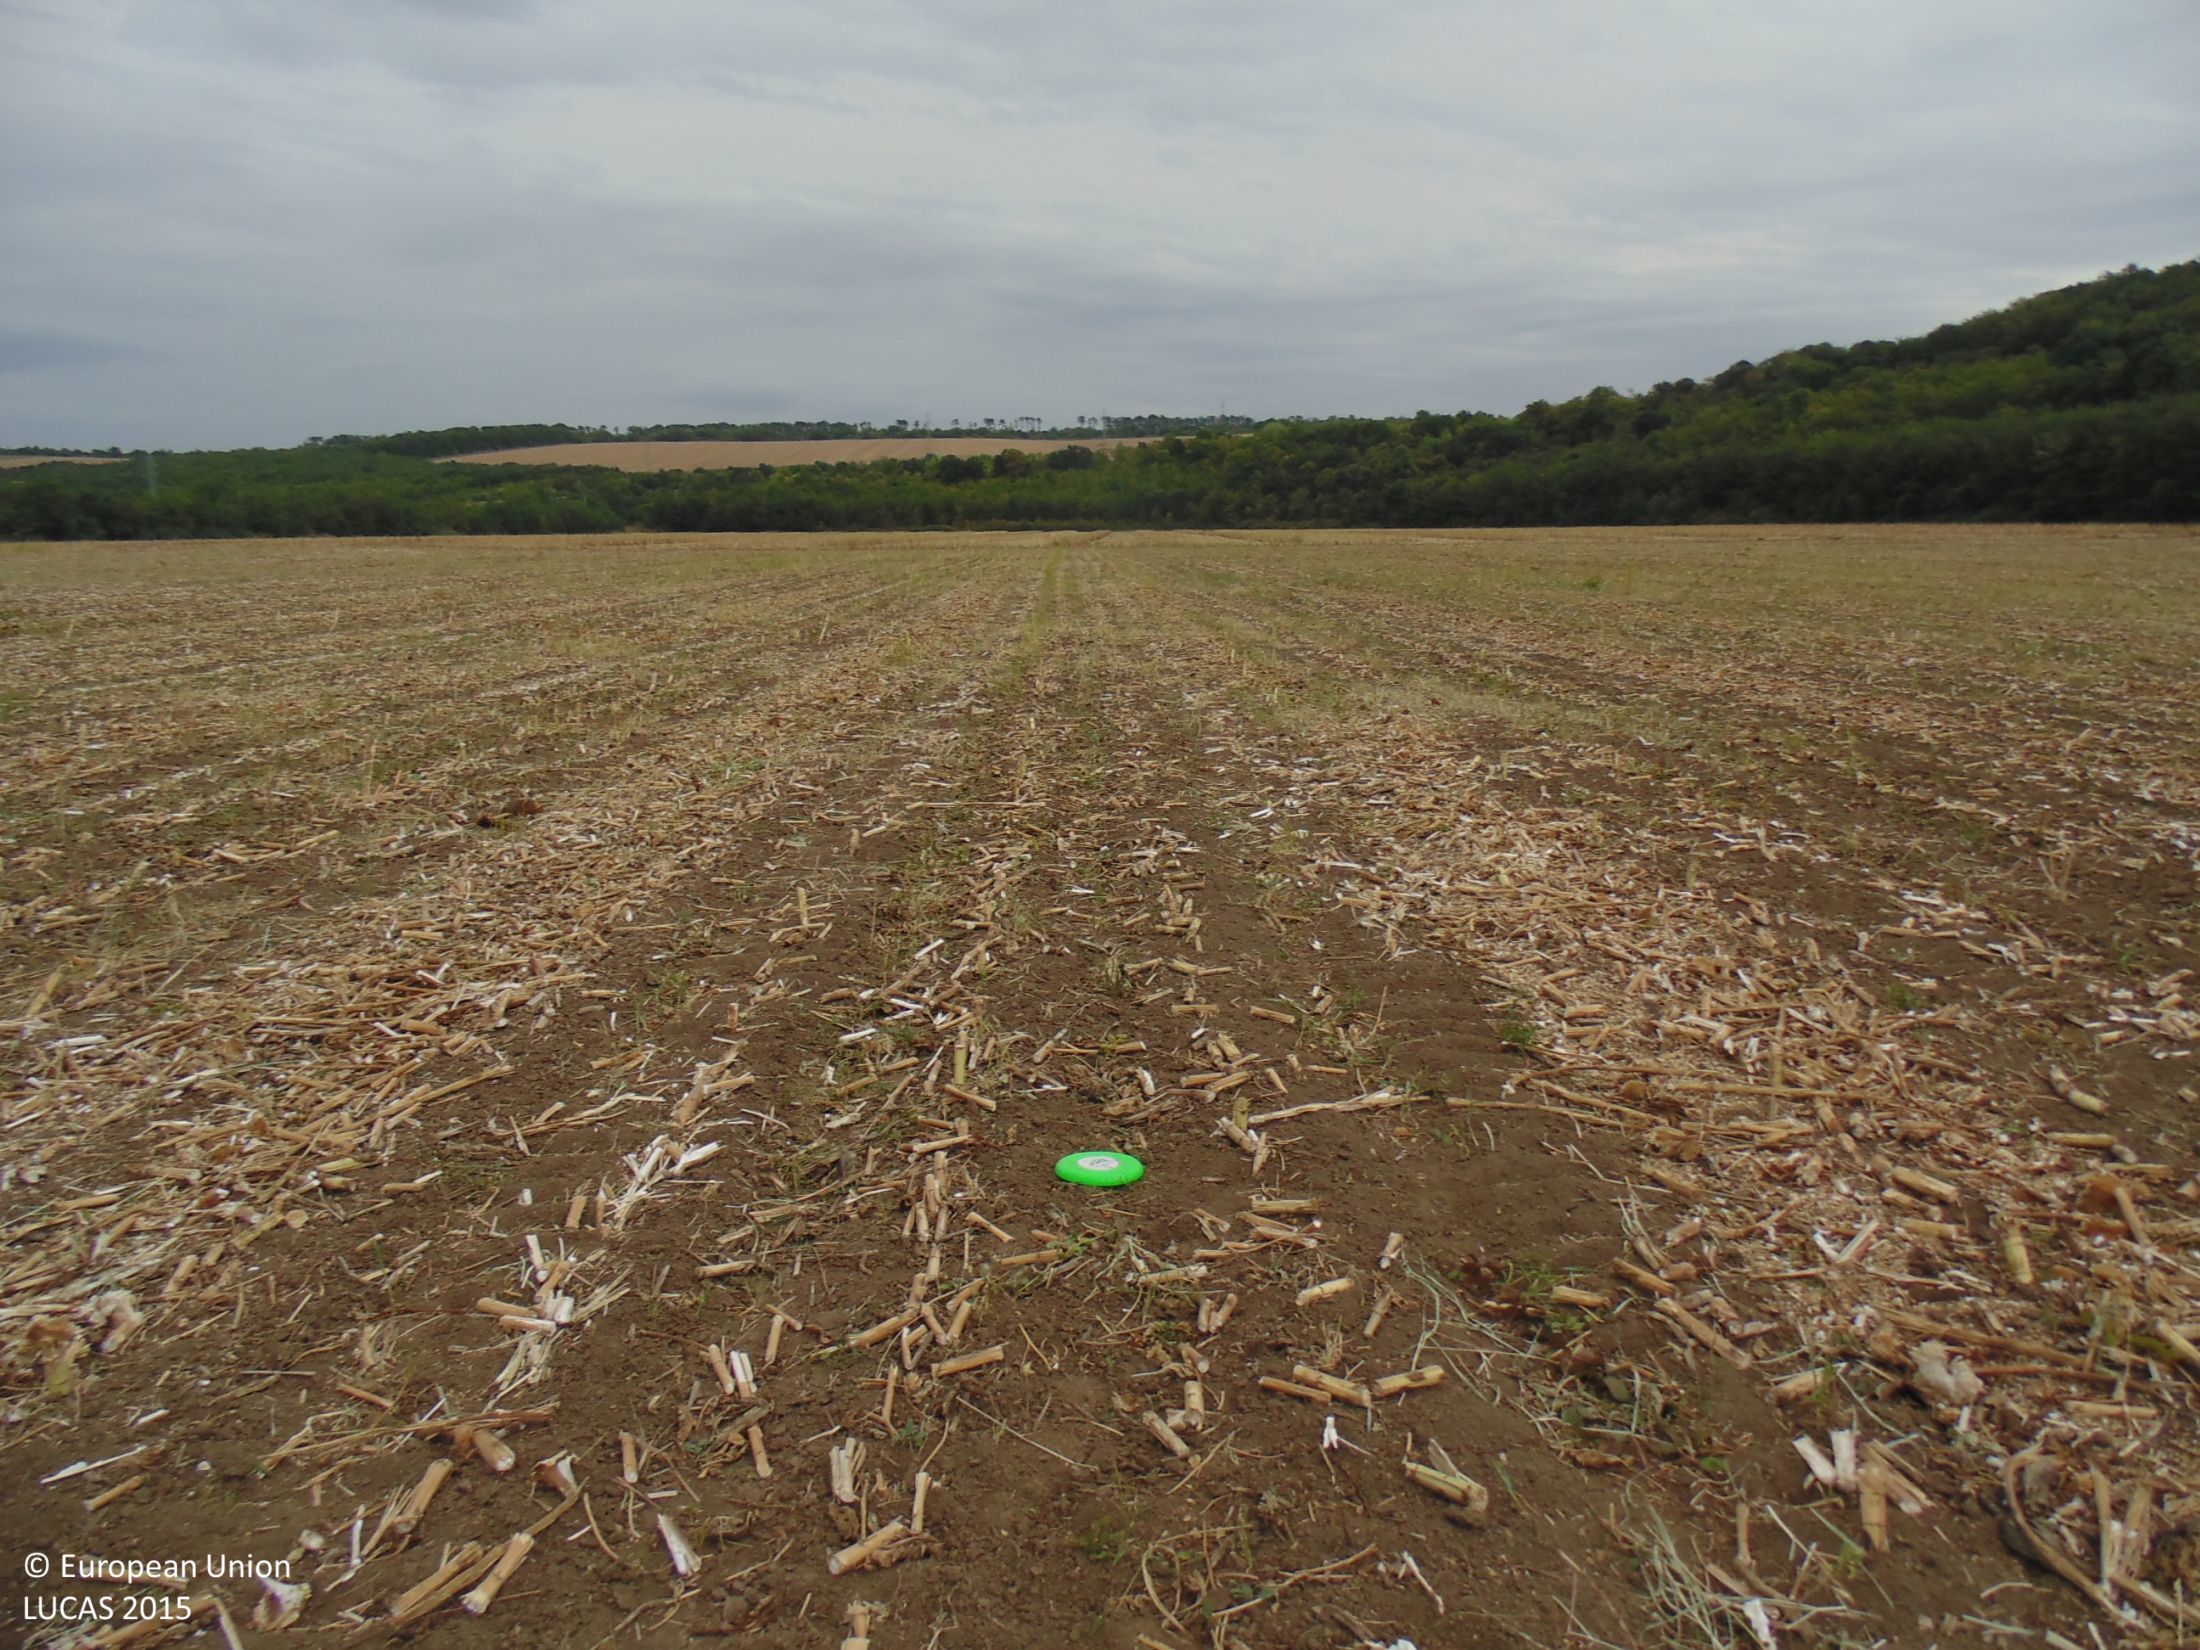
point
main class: Cropland
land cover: Sunflower
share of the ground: < 10 %
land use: Agriculture (excluding fallow land and kitchen gardens)
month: September
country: BG
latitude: 44.0327
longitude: 26.9293
